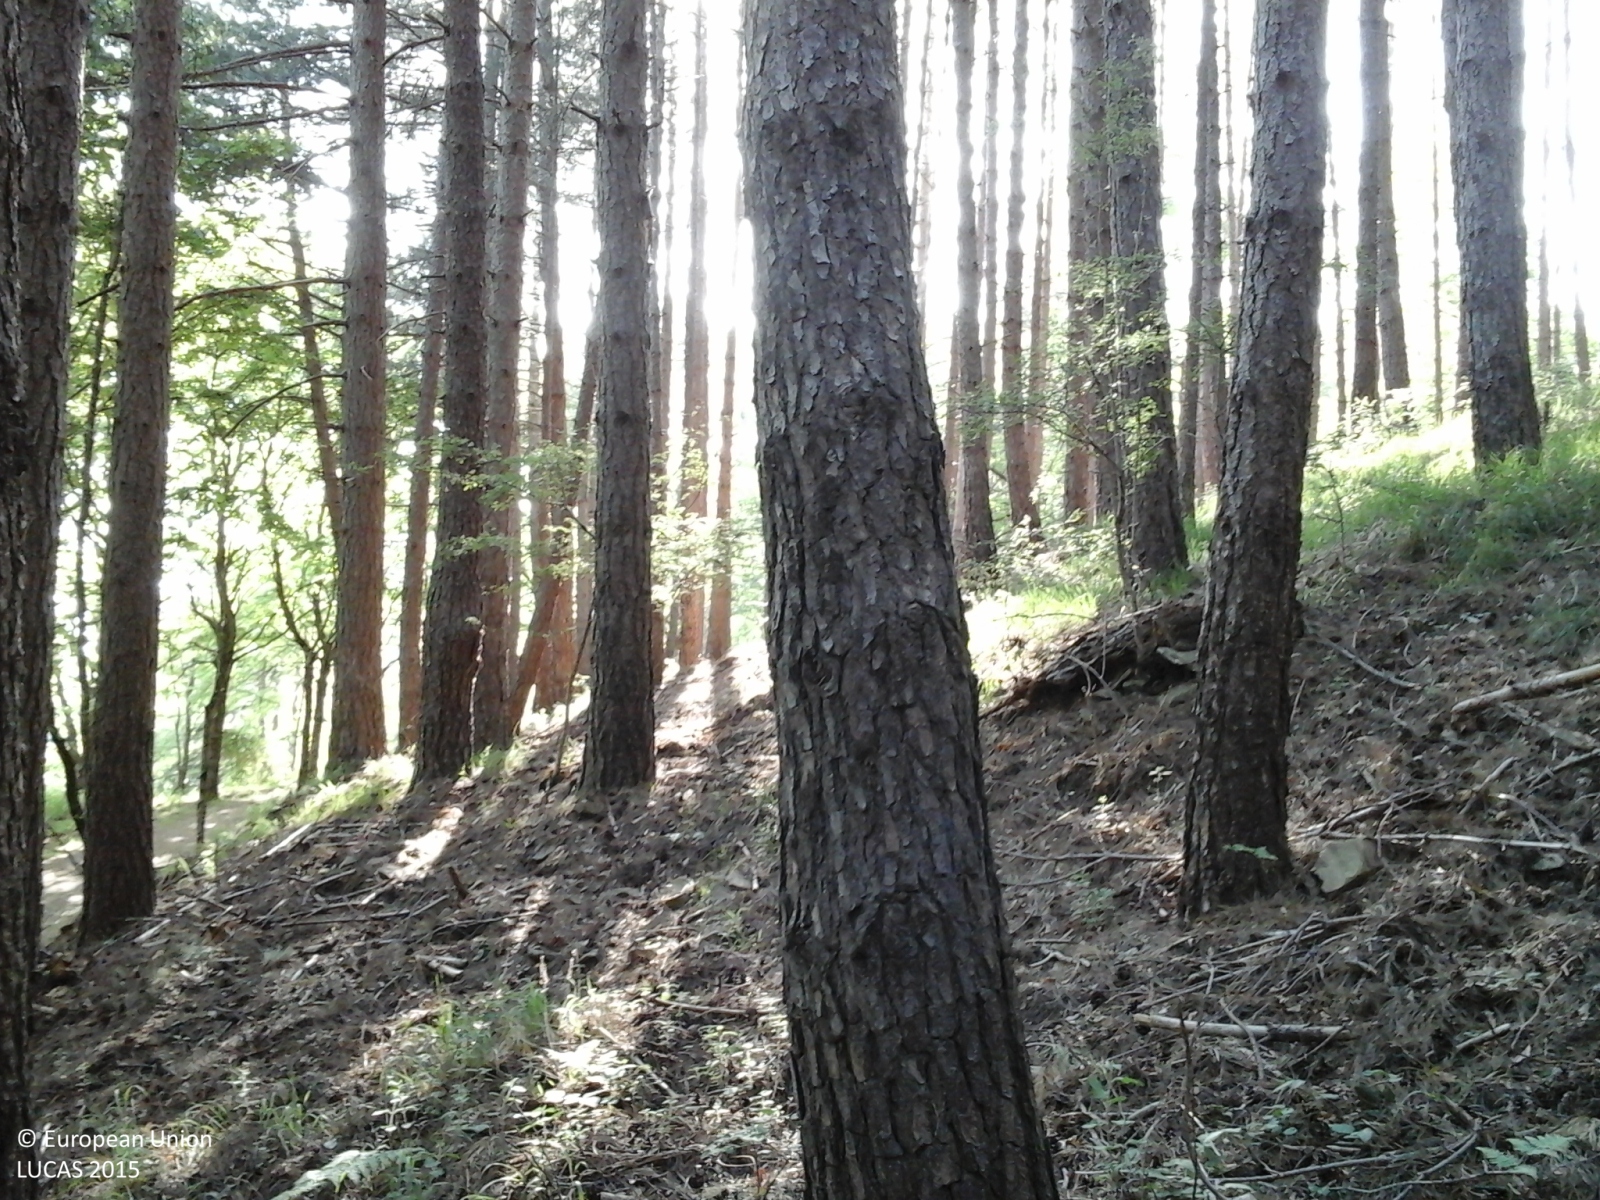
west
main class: Woodland
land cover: Pine dominated coniferous woodland
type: alpine coniferous forest
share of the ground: > 75 %
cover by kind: coniferous forest trees 100 %
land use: Forestry
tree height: > 5 m
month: May
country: IT
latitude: 43.7616
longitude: 11.5486
